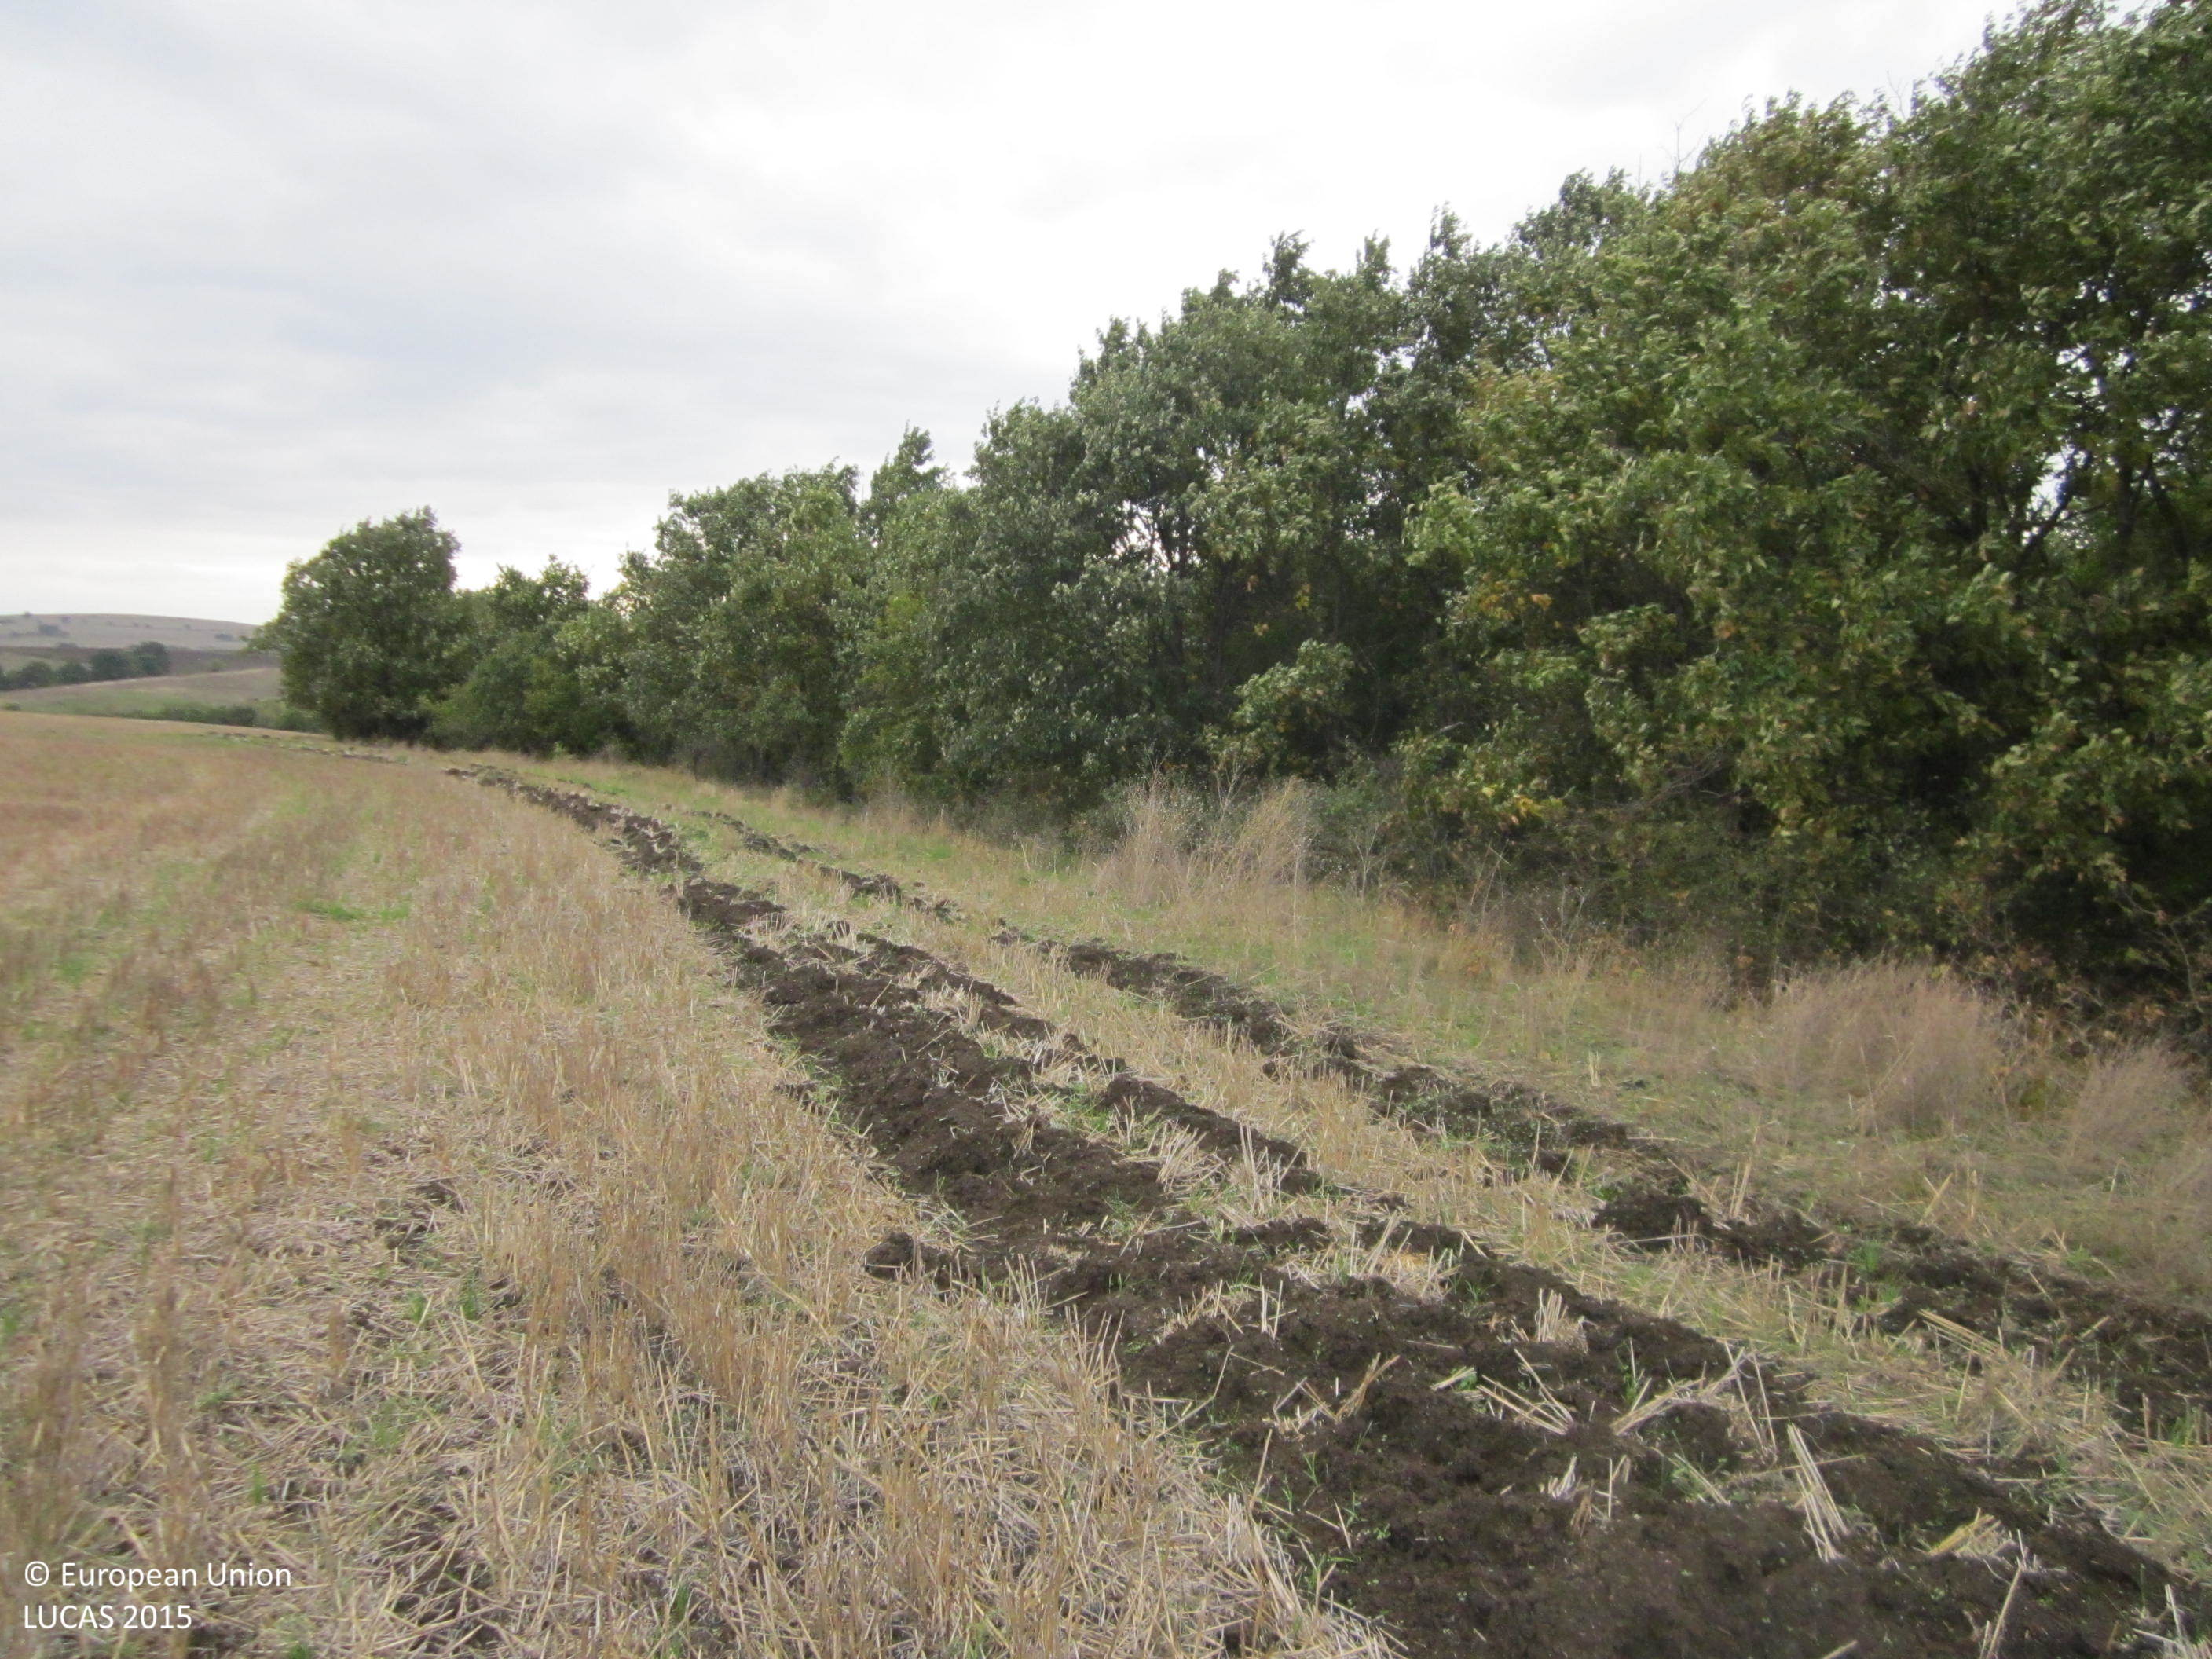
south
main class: Cropland
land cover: Common wheat
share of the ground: 25 - 50 %
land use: Agriculture (excluding fallow land and kitchen gardens)
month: October
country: BG
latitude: 42.3820
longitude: 26.8980
